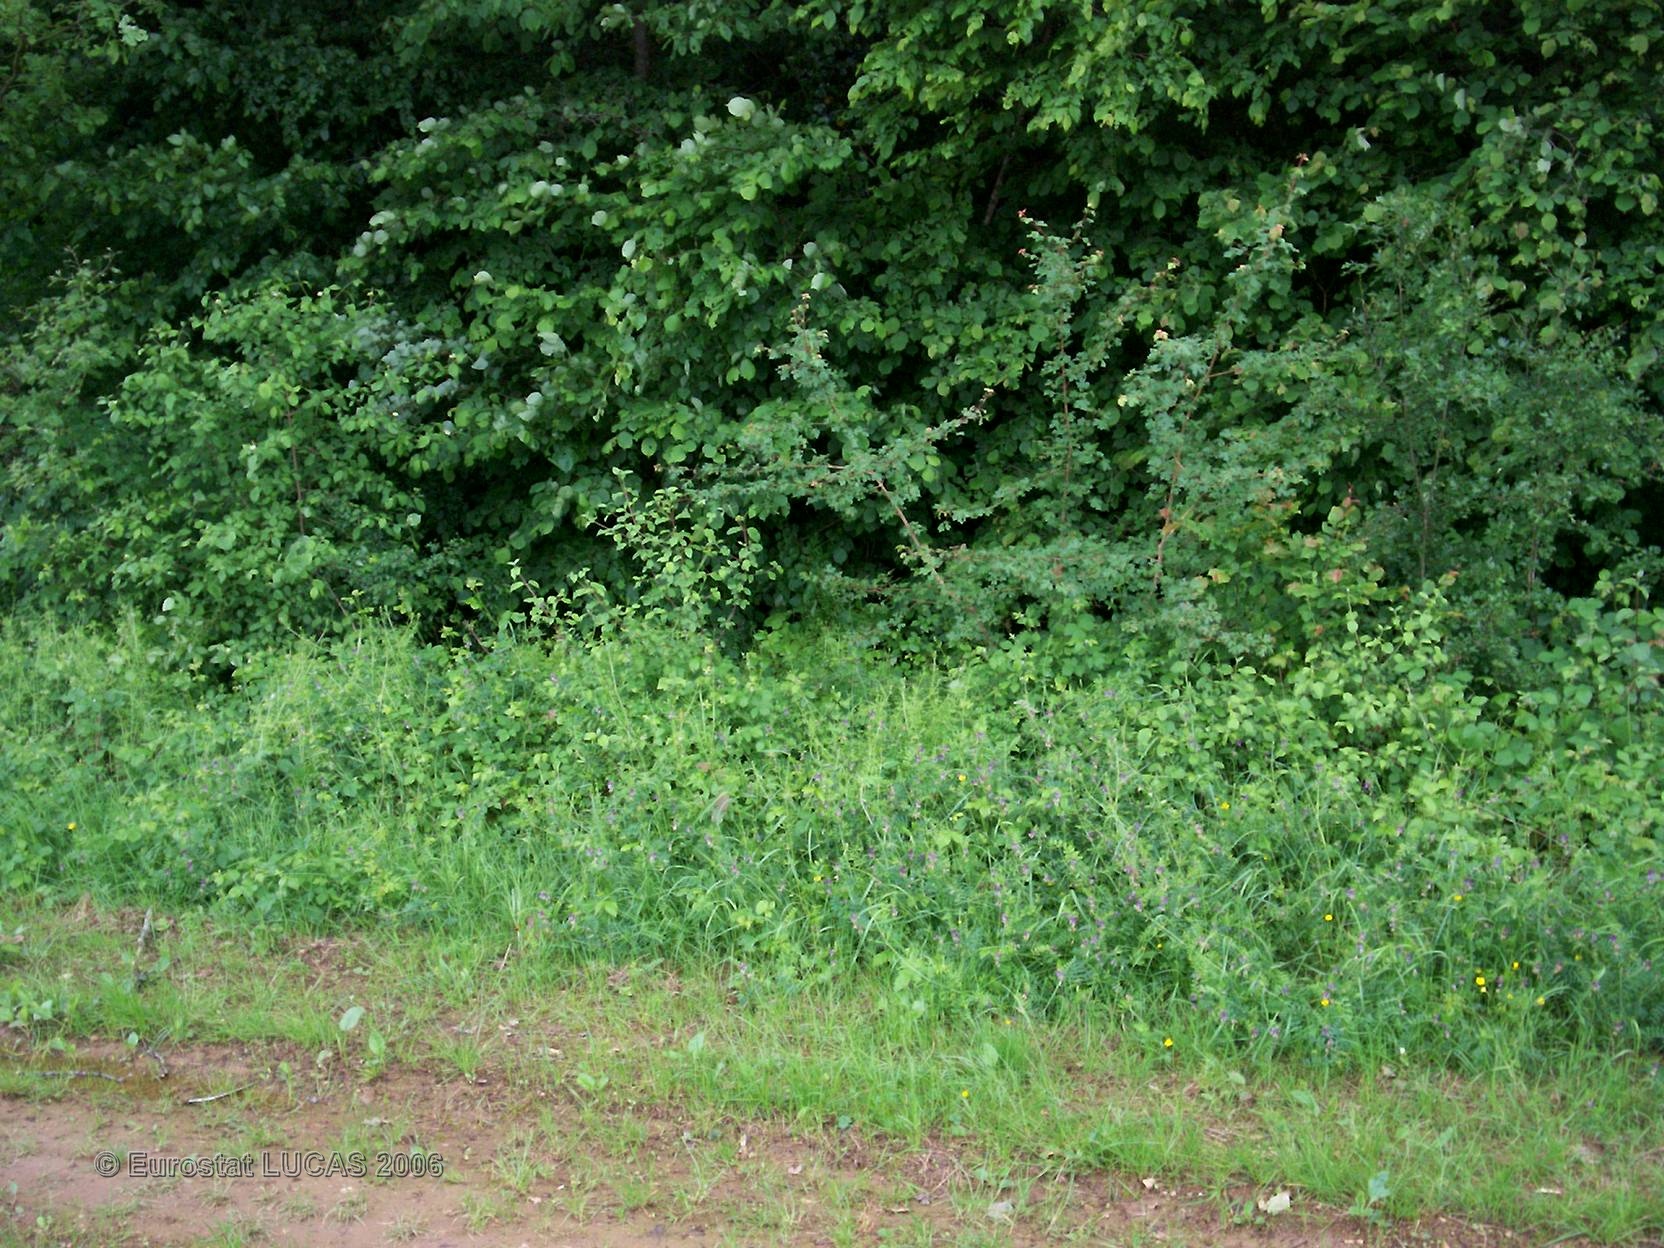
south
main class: Cropland
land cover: Barley
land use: Agriculture (excluding fallow land and kitchen gardens)
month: May
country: FR
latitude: 48.2494
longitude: 4.5164
